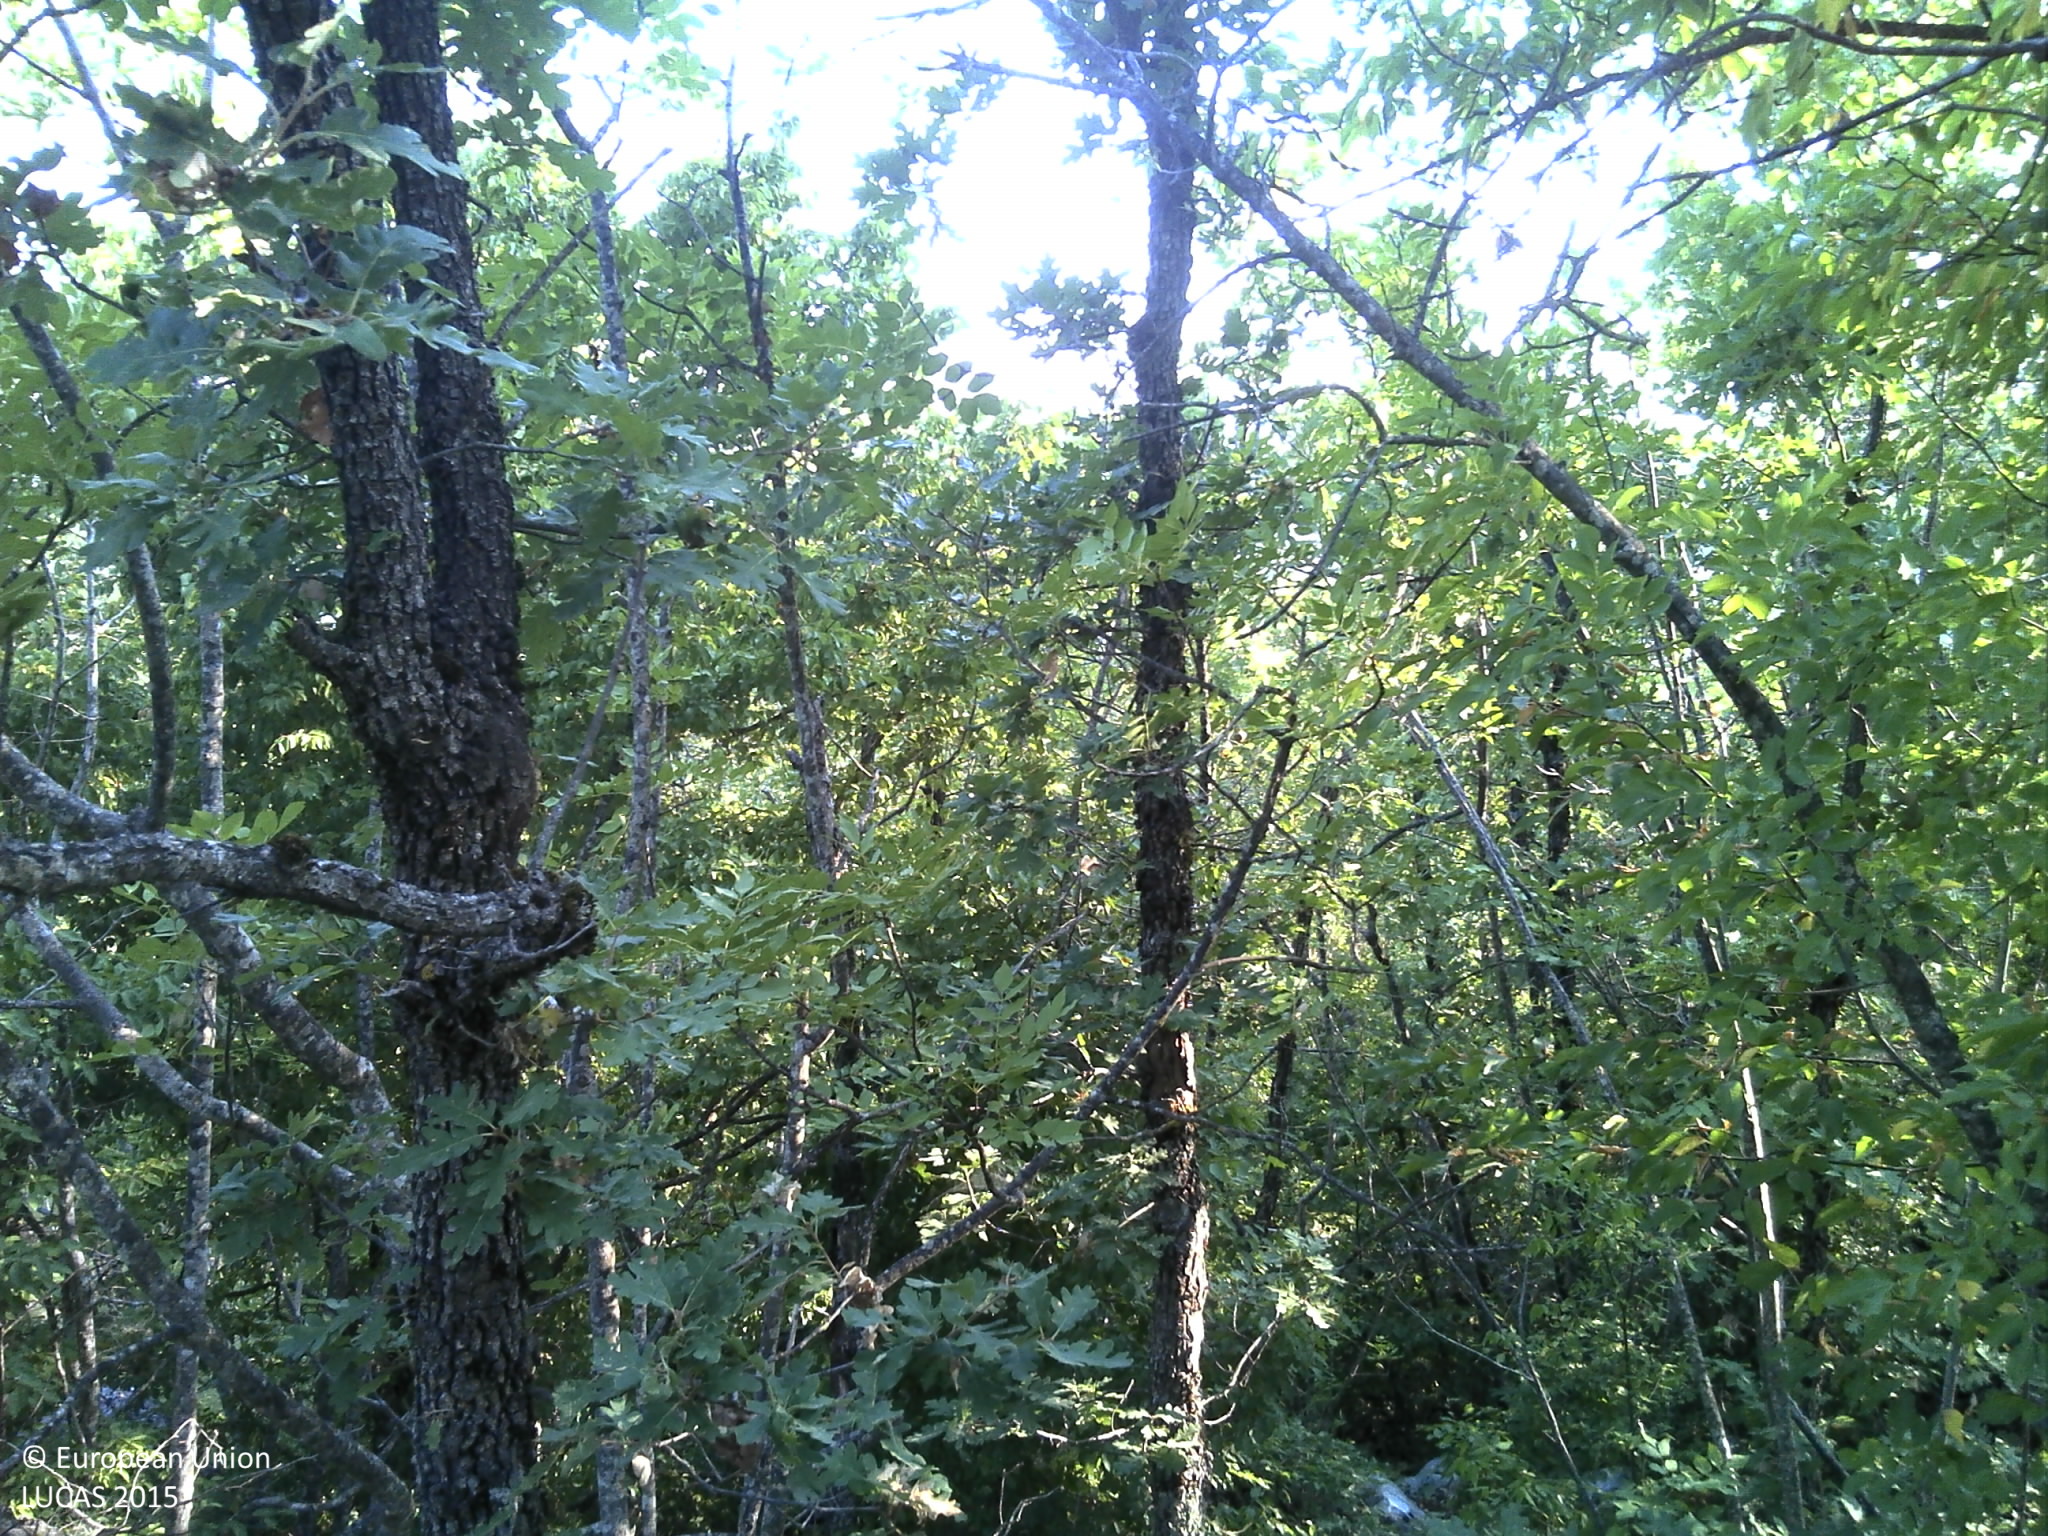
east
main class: Woodland
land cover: Broadleaved woodland
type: thermophilous deciduous forest
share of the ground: 50 - 75 %
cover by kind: broadleaved forest trees 60 %, herbaceous plants 20 %, shrubs 15 %, consolidated bare surface 5 %
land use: Semi-natural and natural areas not in use
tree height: > 5 m
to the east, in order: Broadleaved woodland; Dry stone walls; Broadleaved woodland; Tracks; Broadleaved woodland; Grassland with sparse tree/shrub cover; Broadleaved woodland; Shrubland with sparse tree cover; Dry stone walls; Shrubland with sparse tree cover
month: July
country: HR
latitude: 43.3658
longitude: 17.0869
